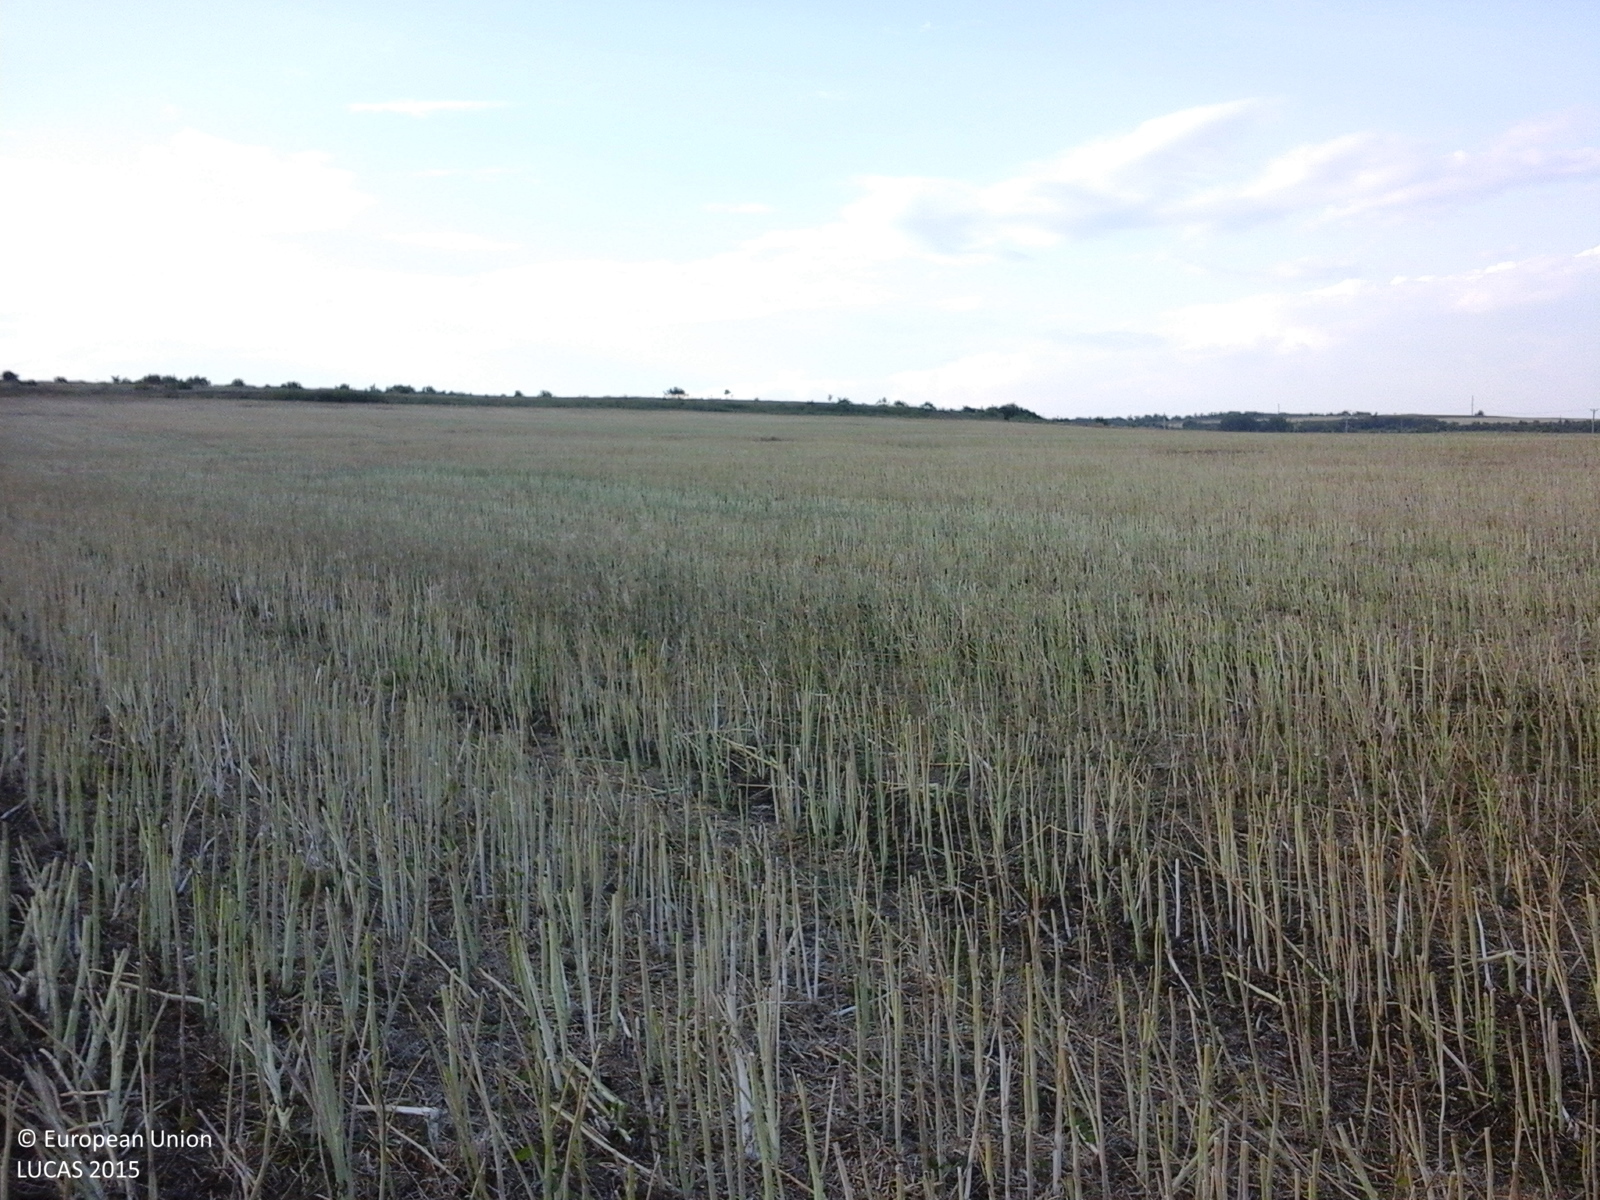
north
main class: Cropland
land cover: Rape and turnip rape
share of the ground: < 10 %
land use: Agriculture (excluding fallow land and kitchen gardens)
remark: Harvested field
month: July
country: RO
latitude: 43.9128
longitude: 25.8463
